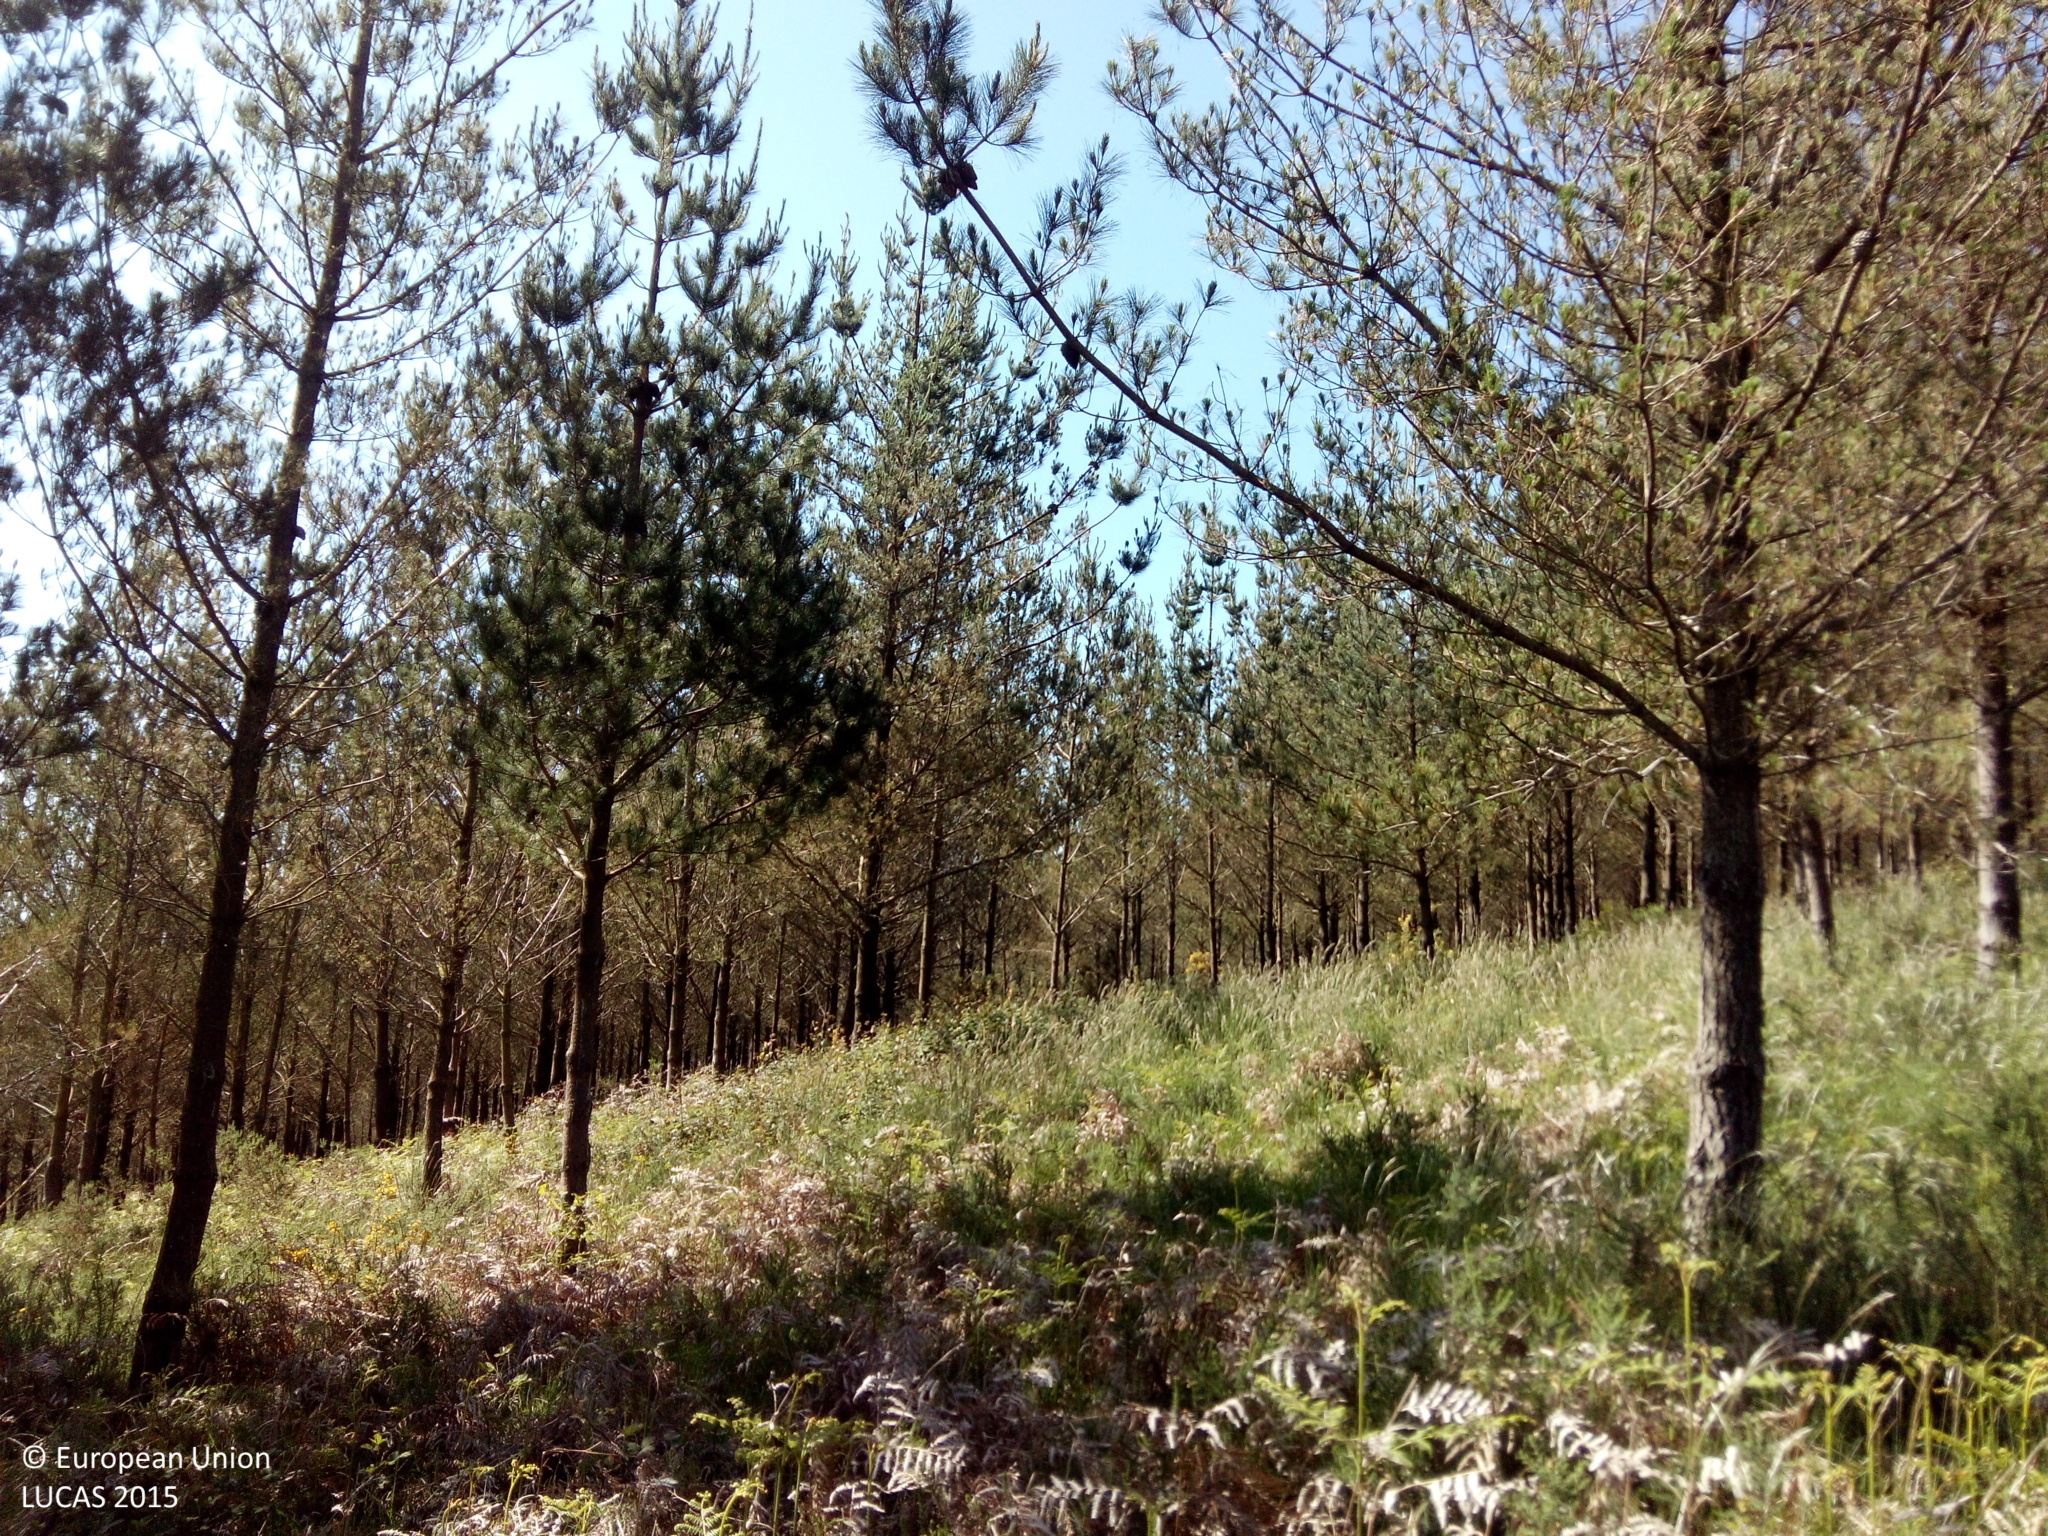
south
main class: Woodland
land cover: Pine dominated coniferous woodland
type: hemiboreal forest and nemoral coniferous forest and mixed broadleaved-coniferous forest
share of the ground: > 75 %
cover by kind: coniferous forest trees 75 %, herbaceous plants 20 %, shrubs 5 %
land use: Forestry
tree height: > 5 m
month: May
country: ES
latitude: 42.6669
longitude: -8.4115
